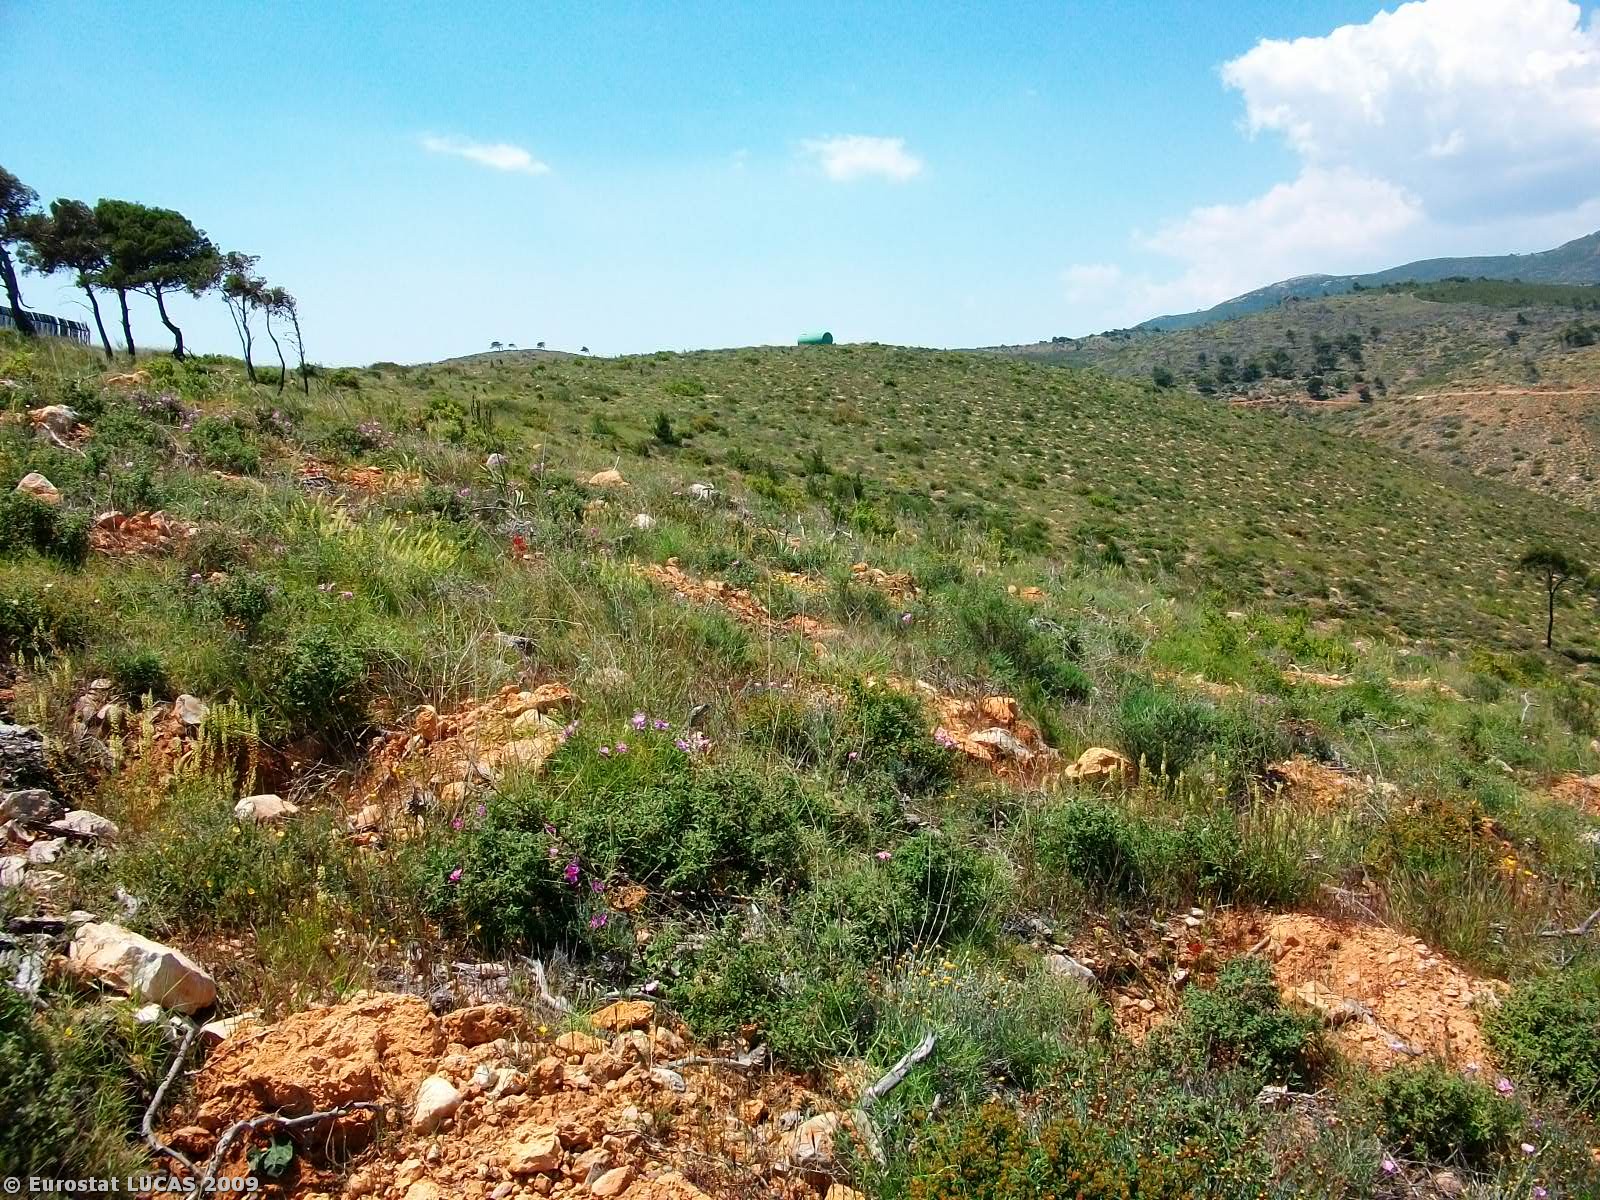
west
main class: Shrubland
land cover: Shrubland without tree cover
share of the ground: > 75 %
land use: Unused
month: May
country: GR
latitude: 38.0342
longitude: 23.9634
